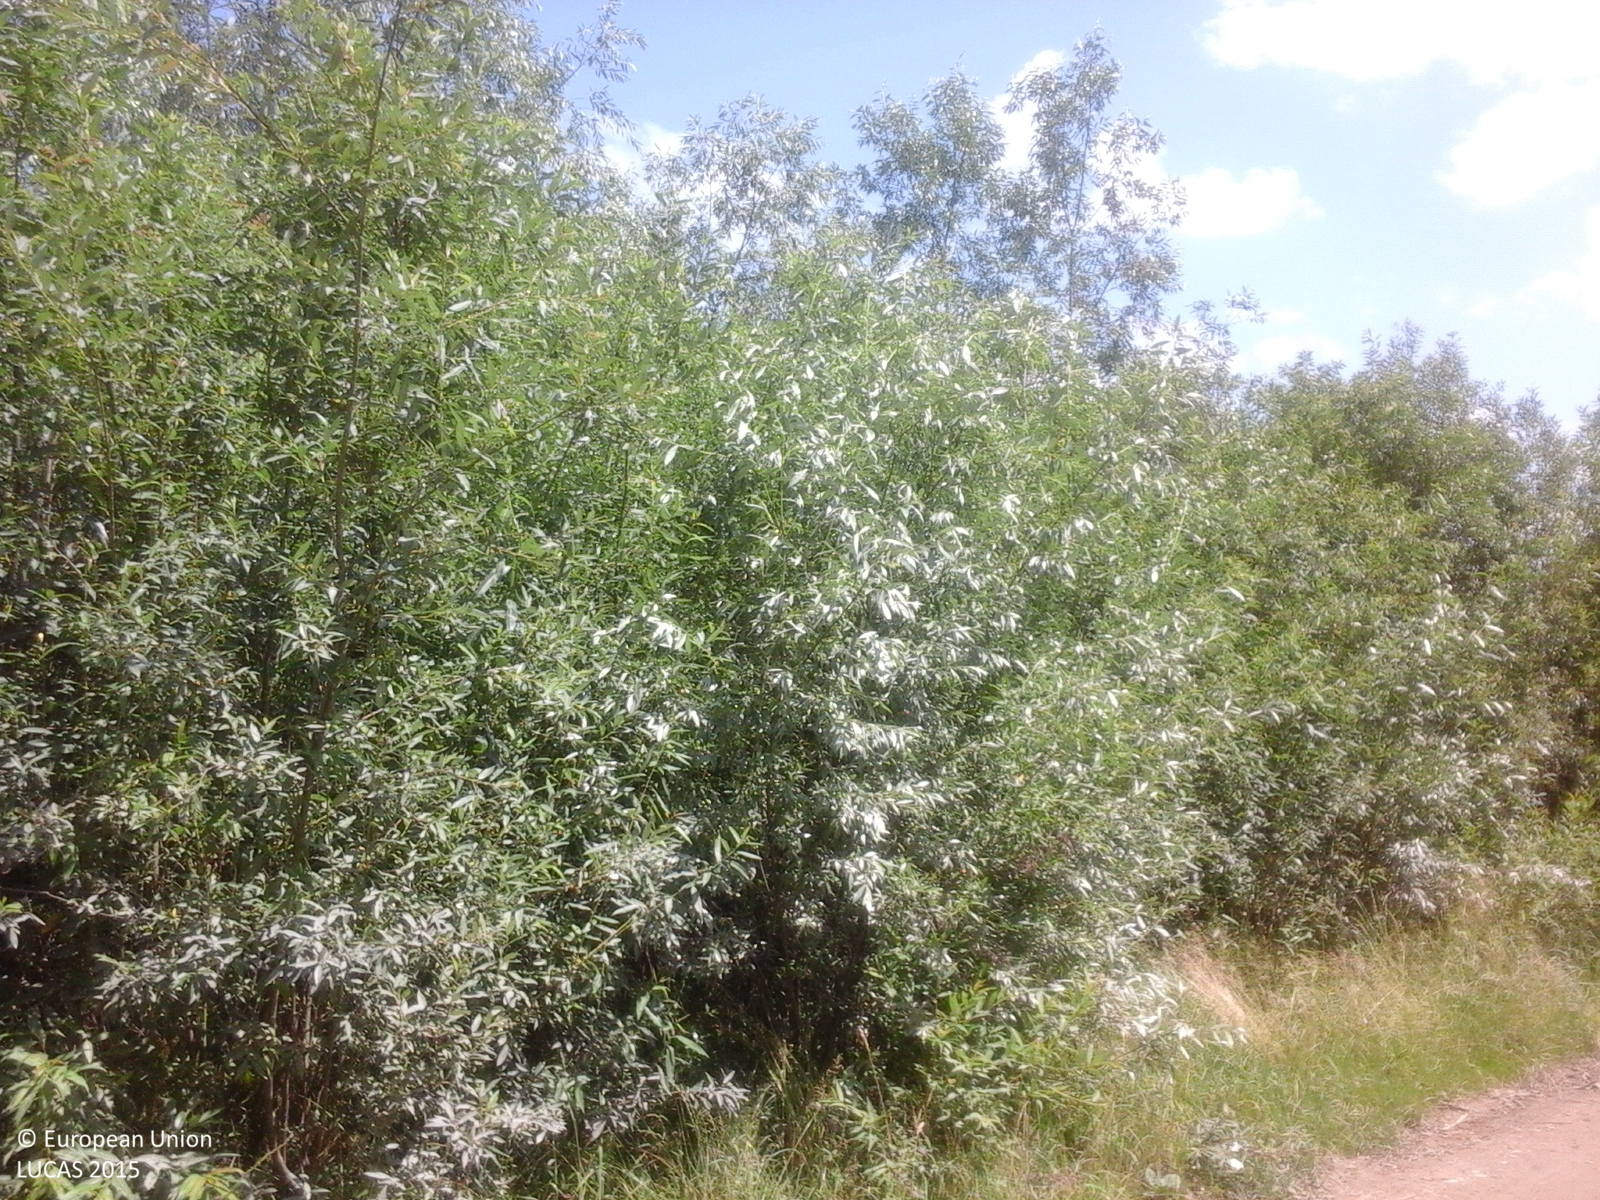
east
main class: Woodland
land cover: Broadleaved woodland
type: thermophilous deciduous forest
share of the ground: > 75 %
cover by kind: broadleaved forest trees 90 %, shrubs 10 %
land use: Semi-natural and natural areas not in use
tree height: > 5 m
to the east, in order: Broadleaved woodland; Grassland without tree/shrub cover; Artificial constructions in urban areas; Grassland without tree/shrub cover; Broadleaved woodland; Grassland without tree/shrub cover
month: June
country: RO
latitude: 47.8271
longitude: 25.7948
